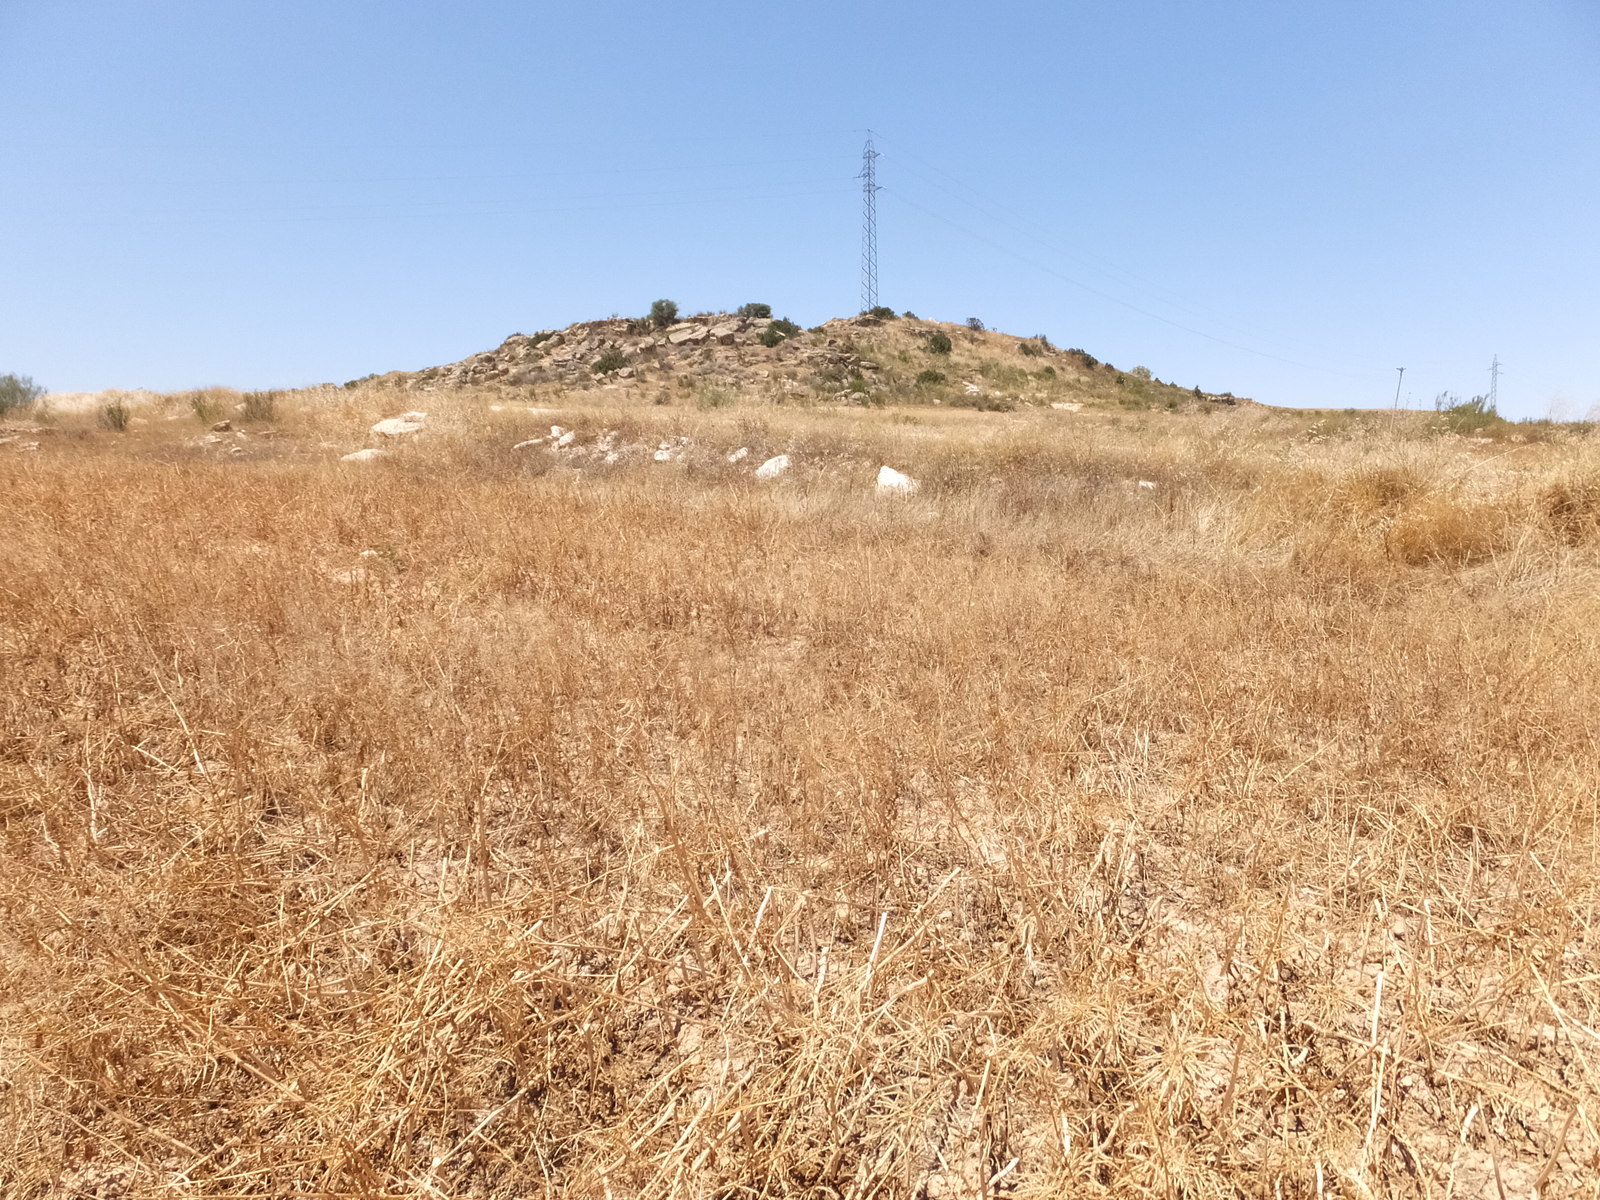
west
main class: Grassland
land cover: Spontaneously vegetated surfaces
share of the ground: > 75 %
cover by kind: herbaceous plants 90 %, unconsolidated bare surface 10 %
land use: Fallow land
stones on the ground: < 10 %
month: June
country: ES
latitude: 41.2948
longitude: -0.0802
